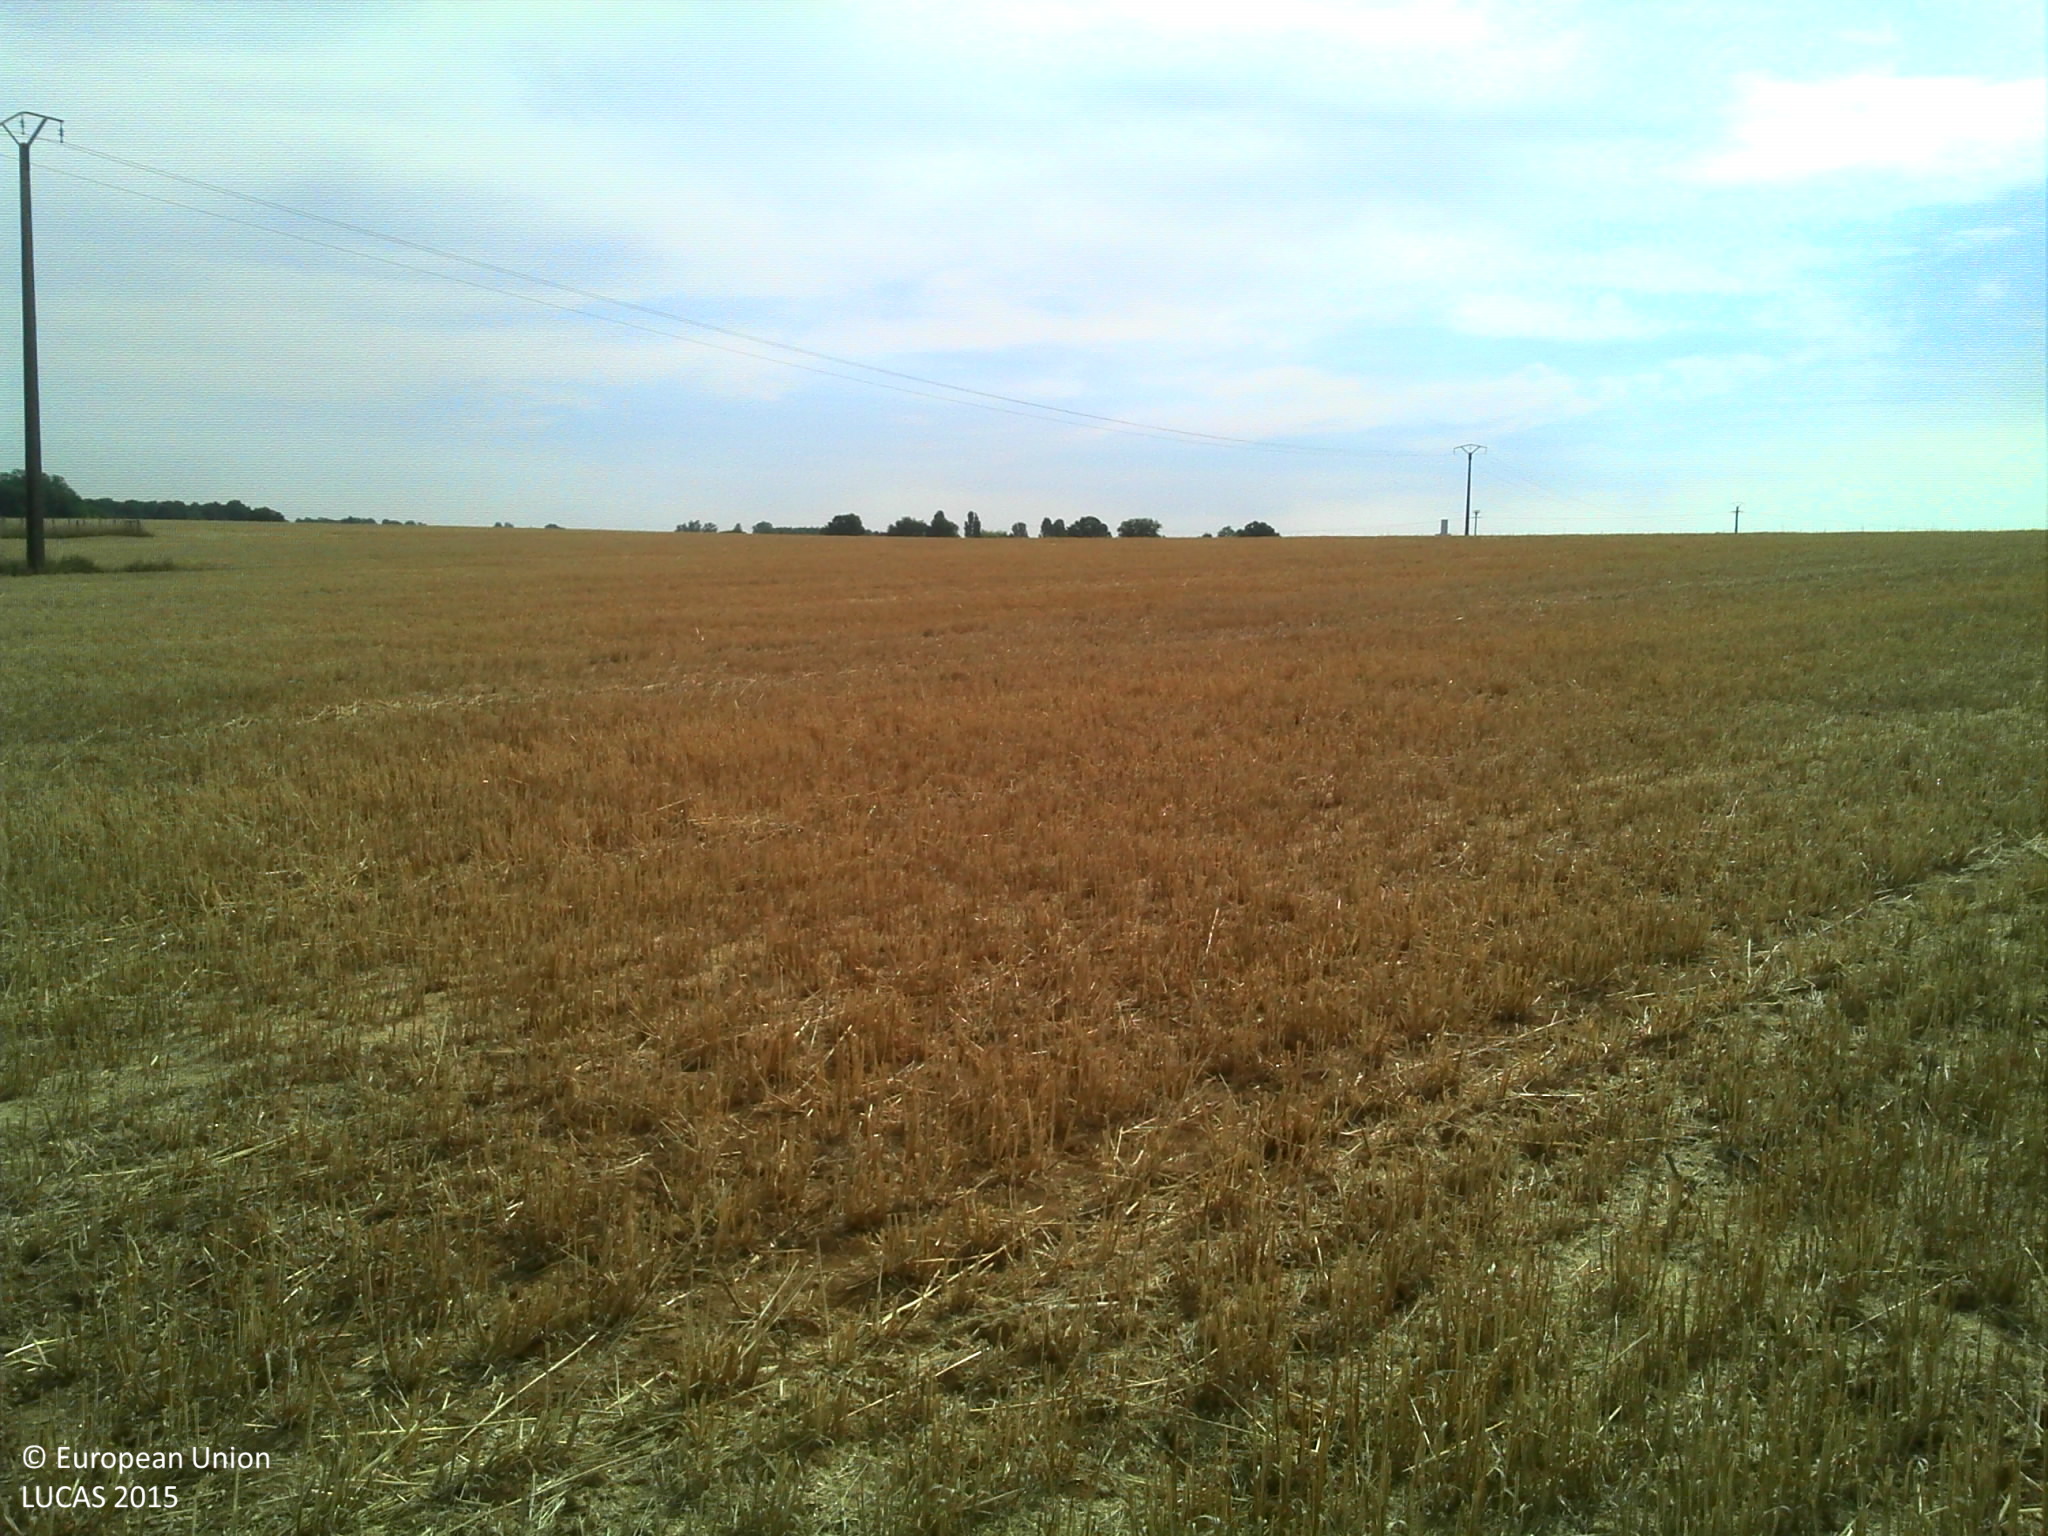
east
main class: Cropland
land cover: Common wheat
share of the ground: > 75 %
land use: Agriculture (excluding fallow land and kitchen gardens)
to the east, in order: Common wheat; Electric lines; Common wheat
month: August
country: FR
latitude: 48.9055
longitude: 3.3212
